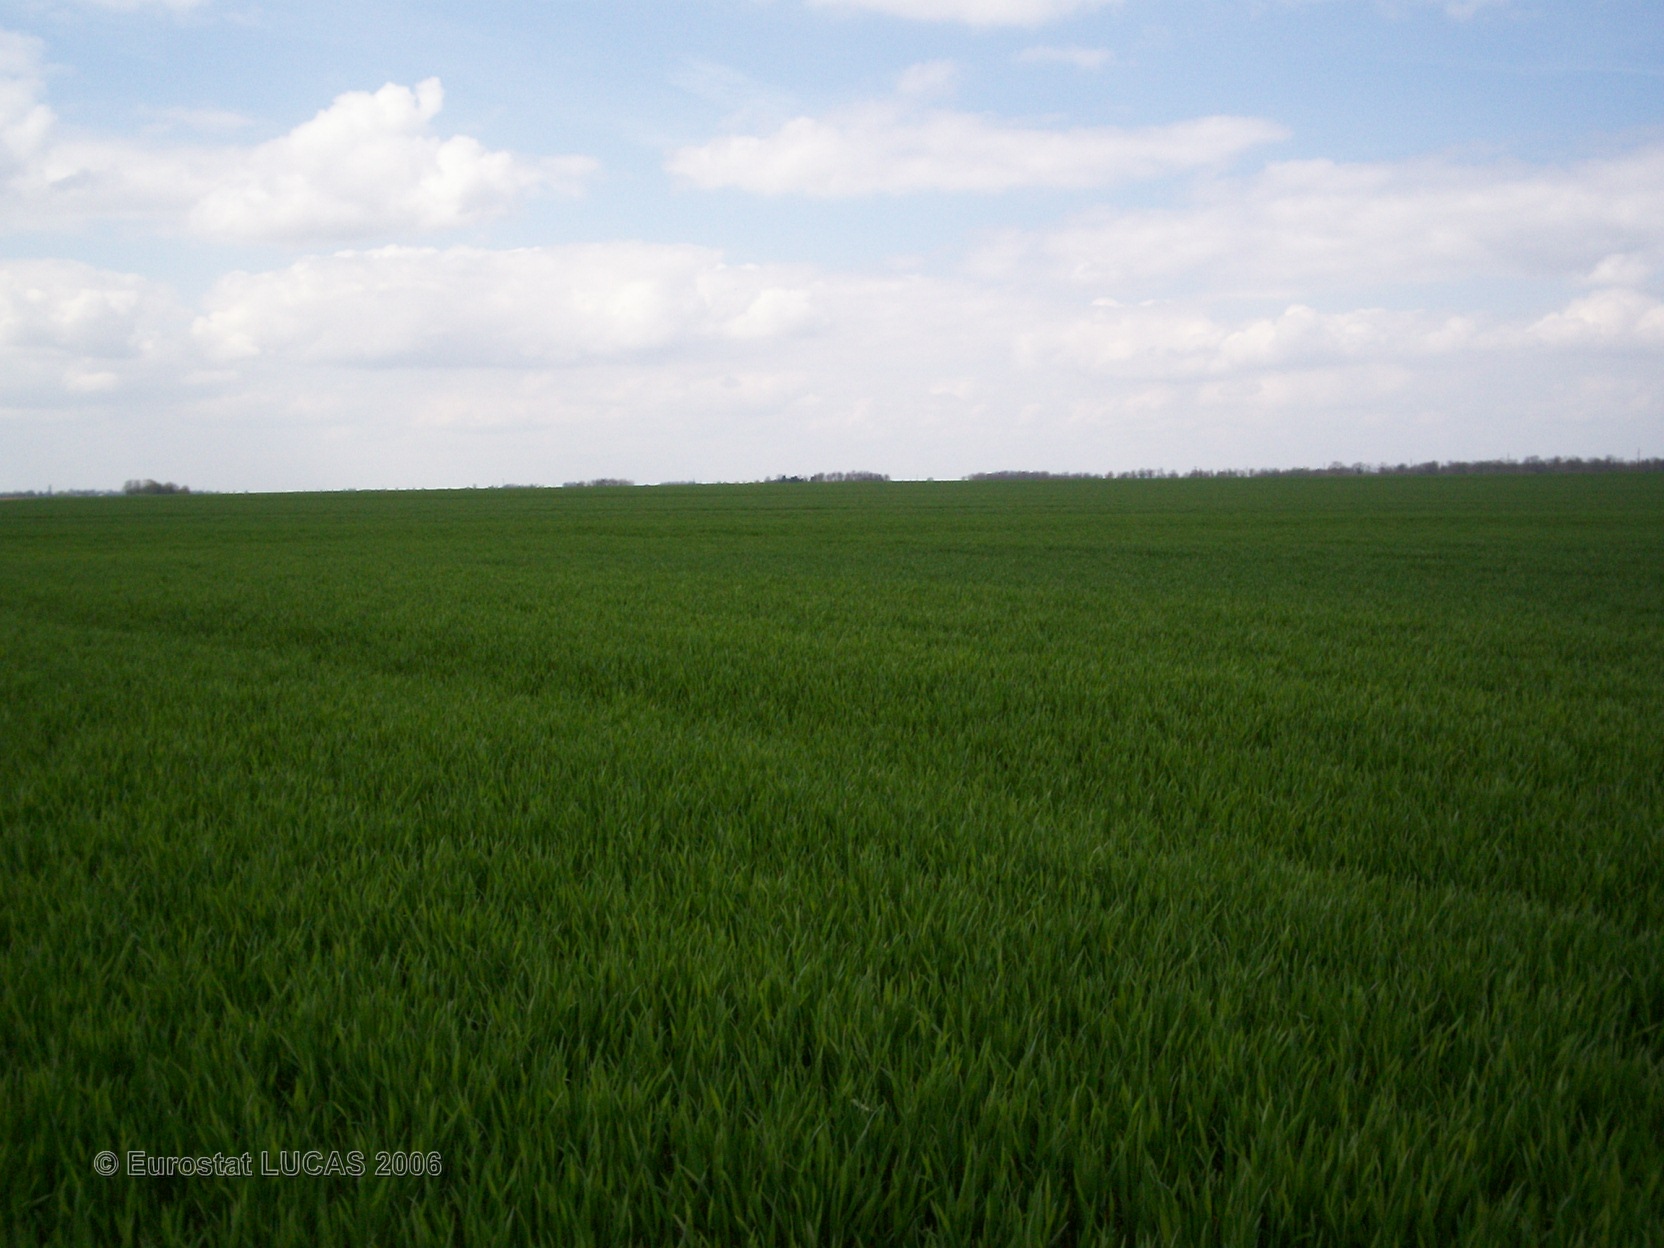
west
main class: Cropland
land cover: Common wheat
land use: Agriculture (excluding fallow land and kitchen gardens)
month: April
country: FR
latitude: 49.1244
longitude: 1.0303
